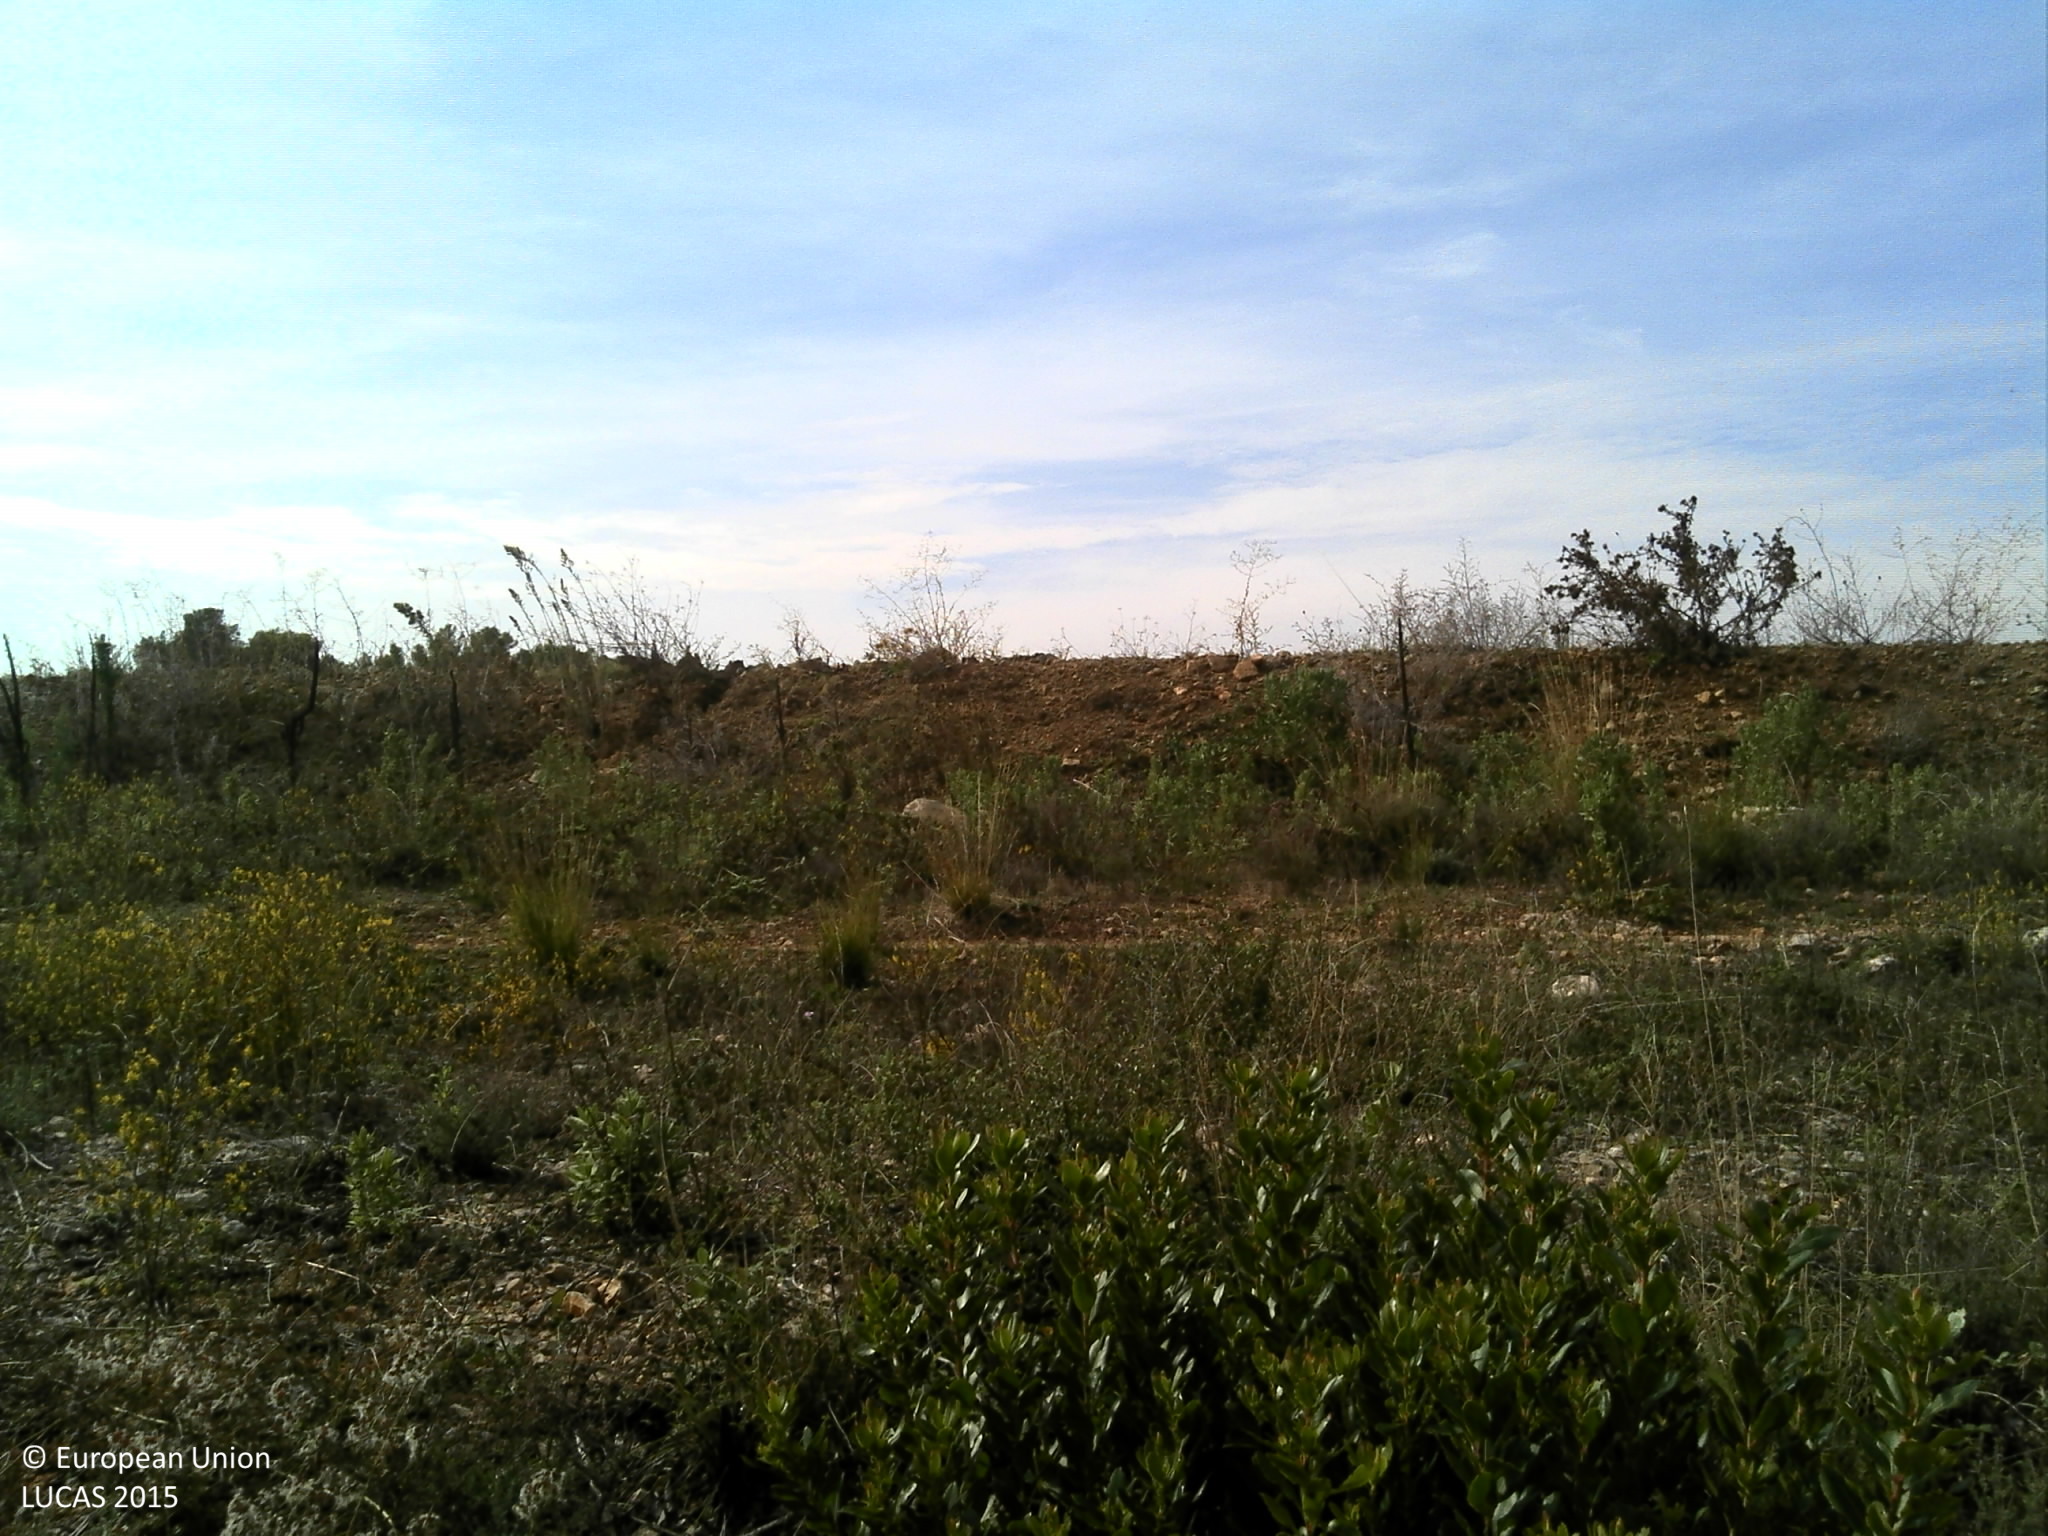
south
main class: Woodland
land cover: Broadleaved woodland
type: broadleaved evergreen forest
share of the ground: > 75 %
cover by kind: broadleaved forest trees 80 %, shrubs 10 %, unconsolidated bare surface 10 %
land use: Semi-natural and natural areas not in use
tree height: < 5 m
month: October
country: FR
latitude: 43.4793
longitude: 6.5097
